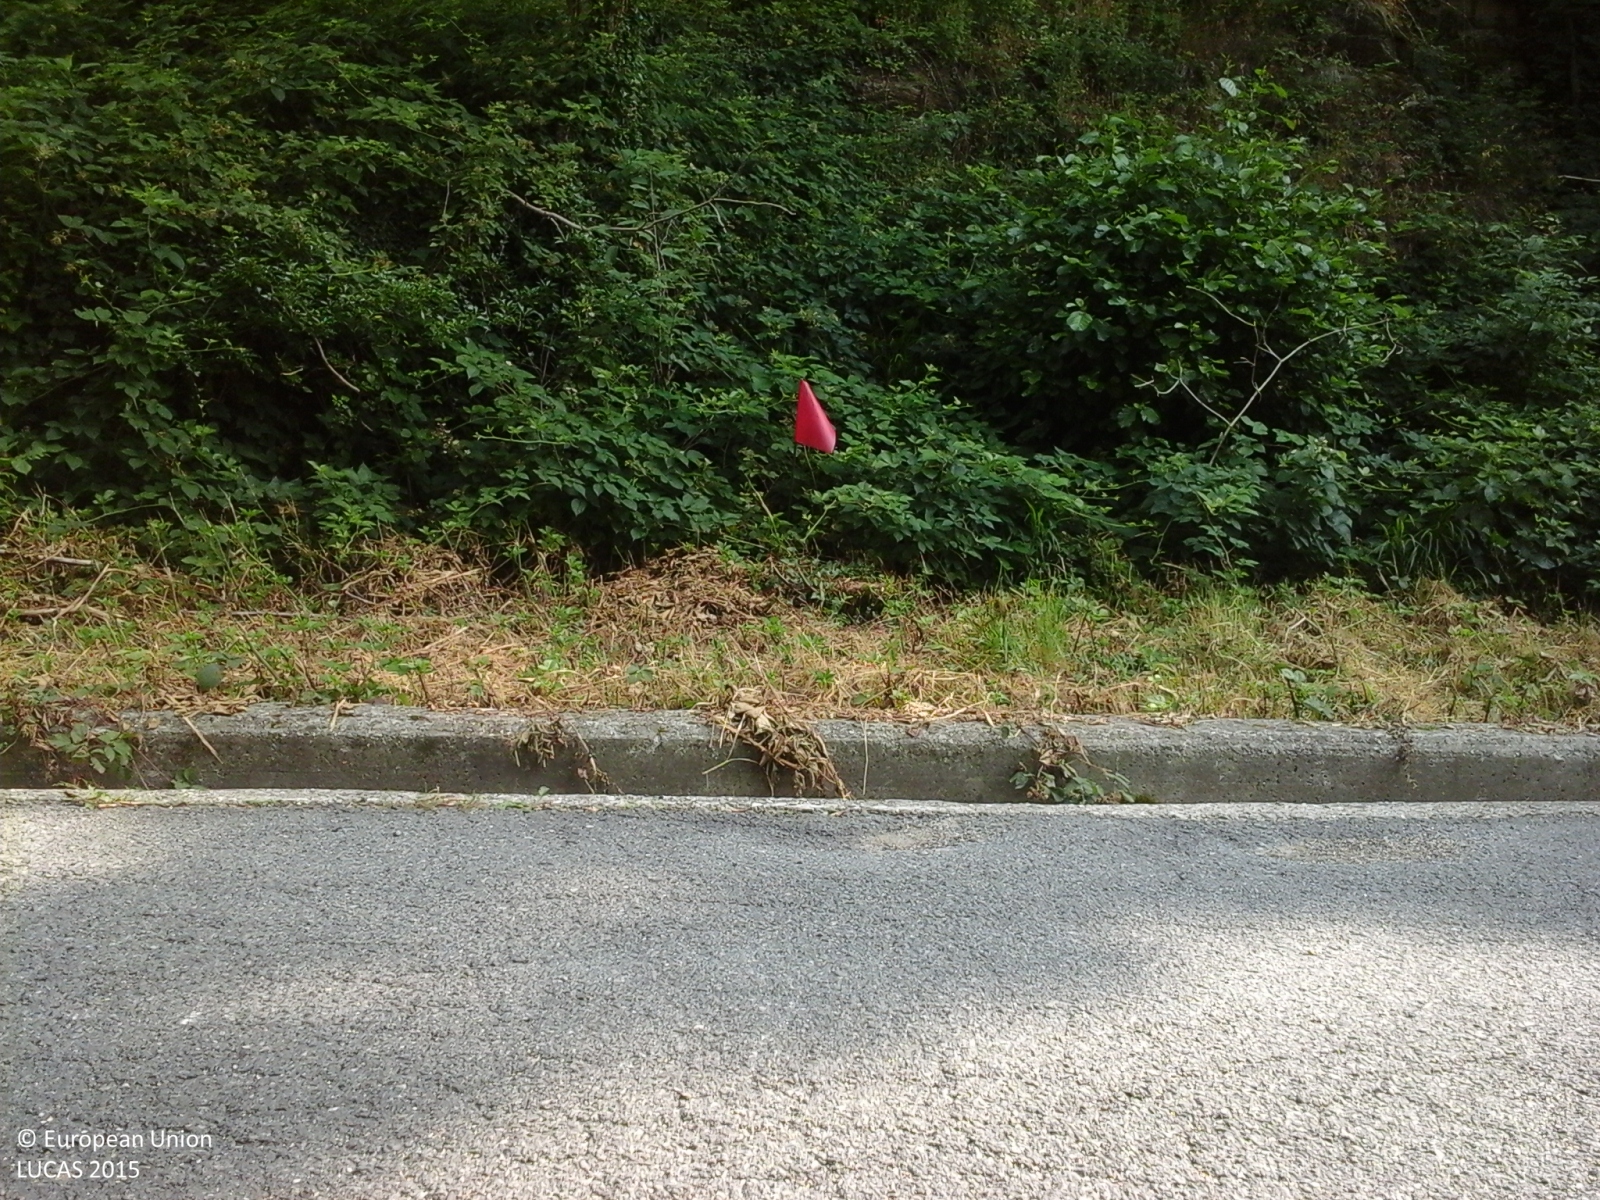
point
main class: Woodland
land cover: Broadleaved woodland
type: mesophytic deciduous forest
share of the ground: > 75 %
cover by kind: broadleaved forest trees 100 %
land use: Forestry
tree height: > 5 m
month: July
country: IT
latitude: 45.0545
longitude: 7.2746
